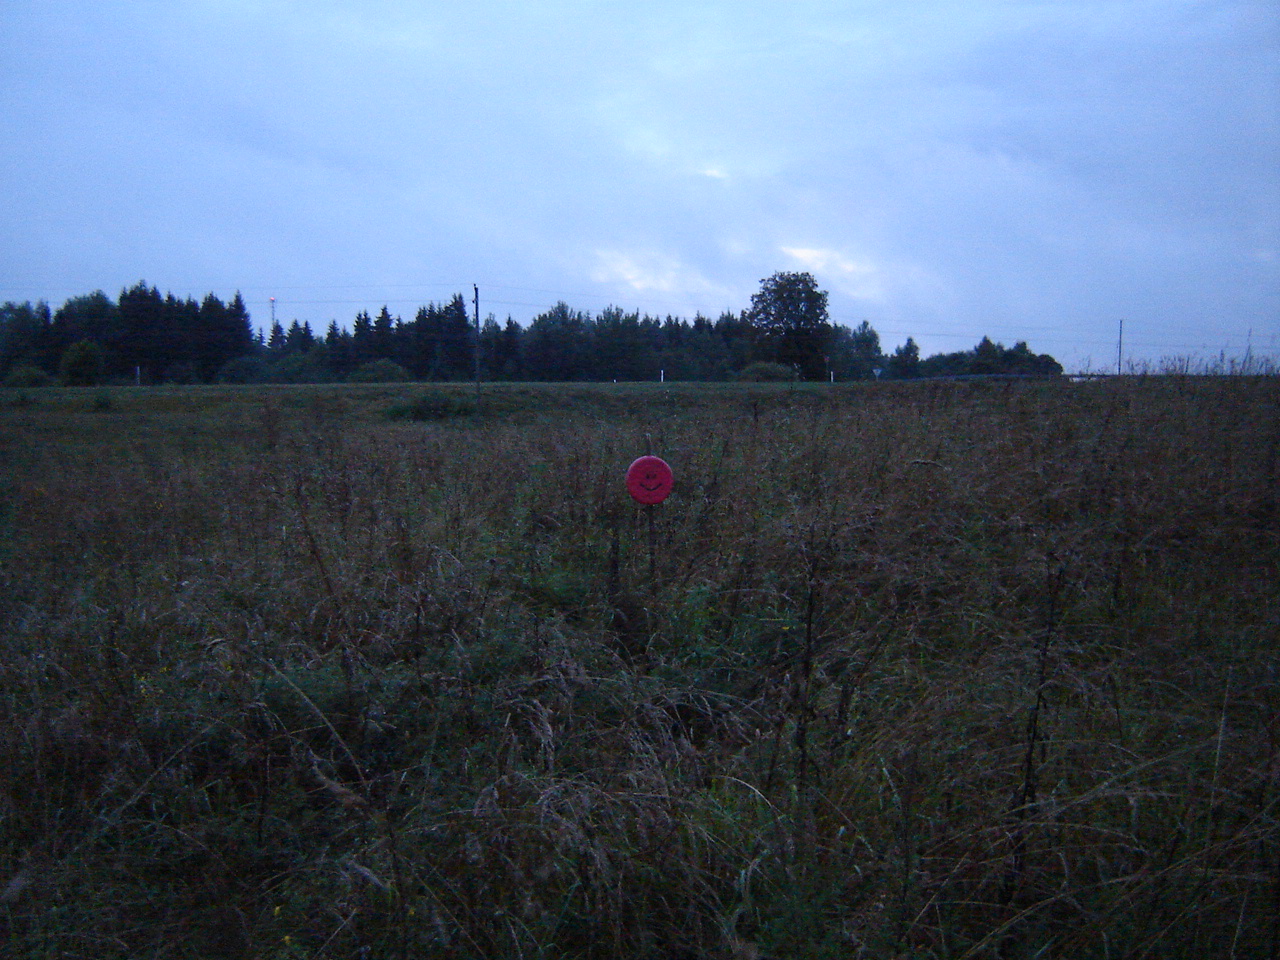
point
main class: Grassland
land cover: Spontaneously vegetated surfaces
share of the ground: > 75 %
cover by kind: herbaceous plants 100 %
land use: Fallow land
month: September
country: LT
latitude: 54.9276
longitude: 25.3368
